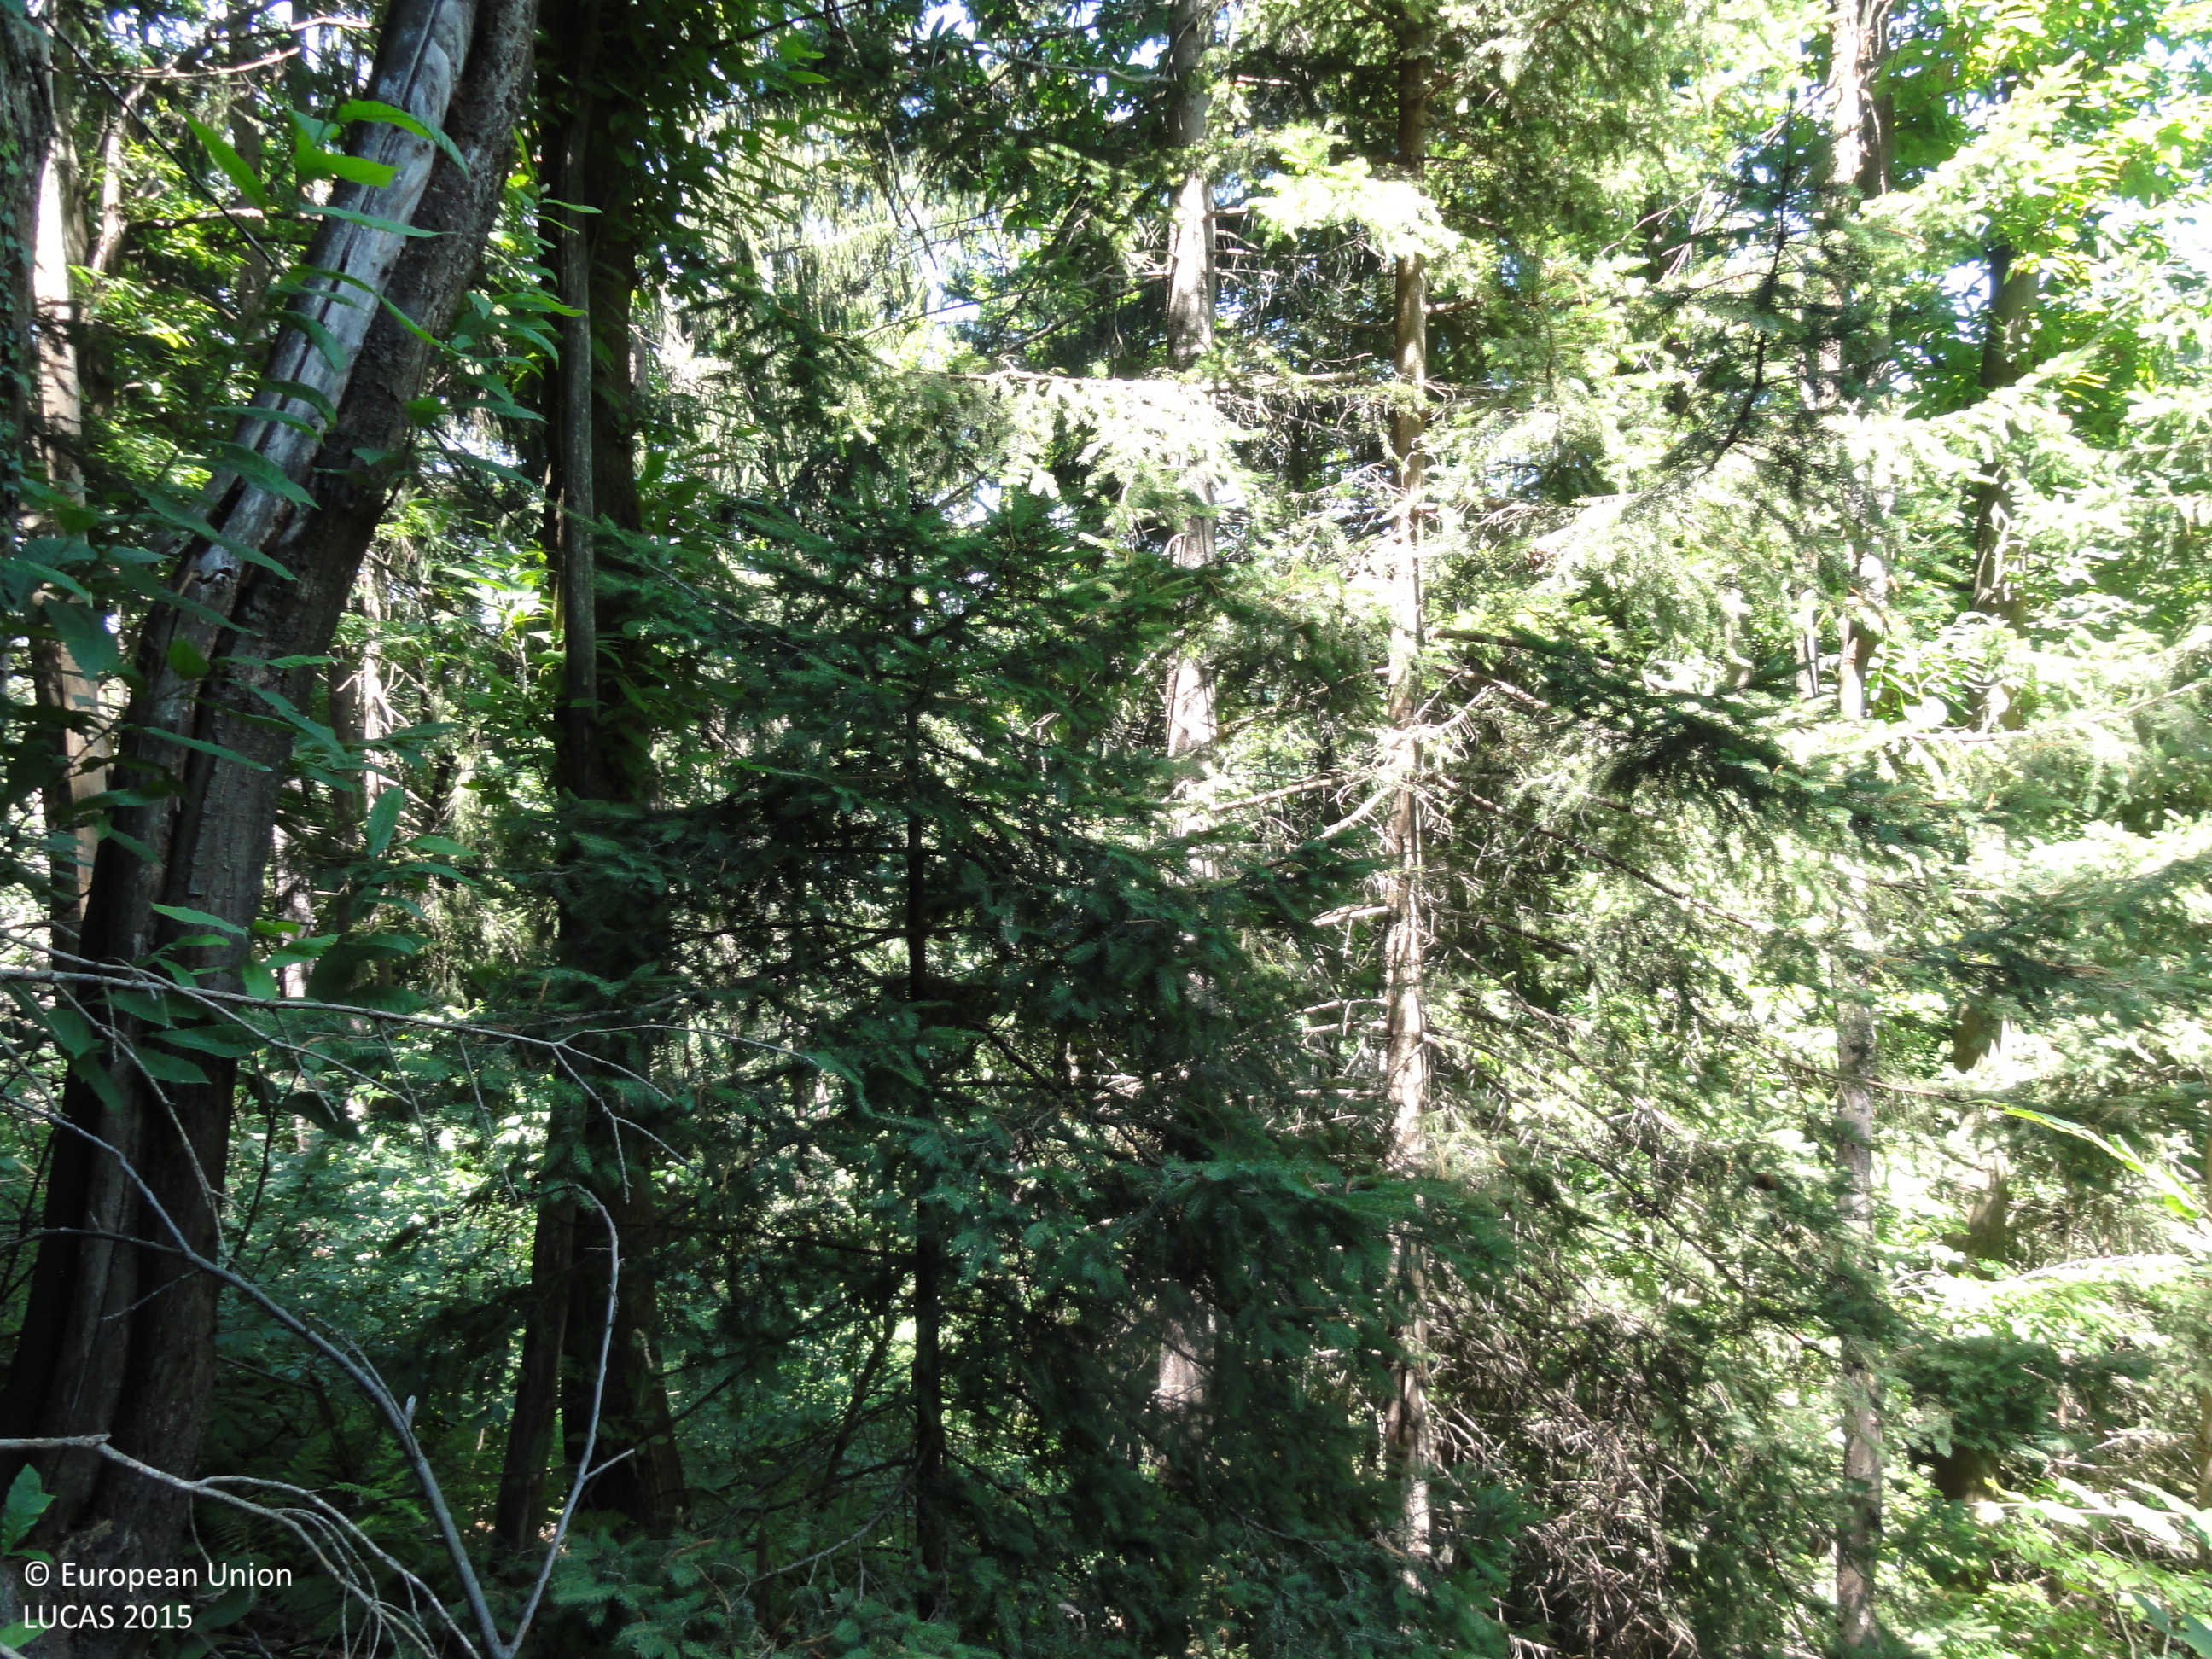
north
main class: Woodland
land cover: Spruce dominated mixed woodland
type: mesophytic deciduous forest
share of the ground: > 75 %
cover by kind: coniferous forest trees 50 %, broadleaved forest trees 50 %
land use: Forestry
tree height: > 5 m
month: July
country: SI
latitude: 46.3197
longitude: 15.1017
